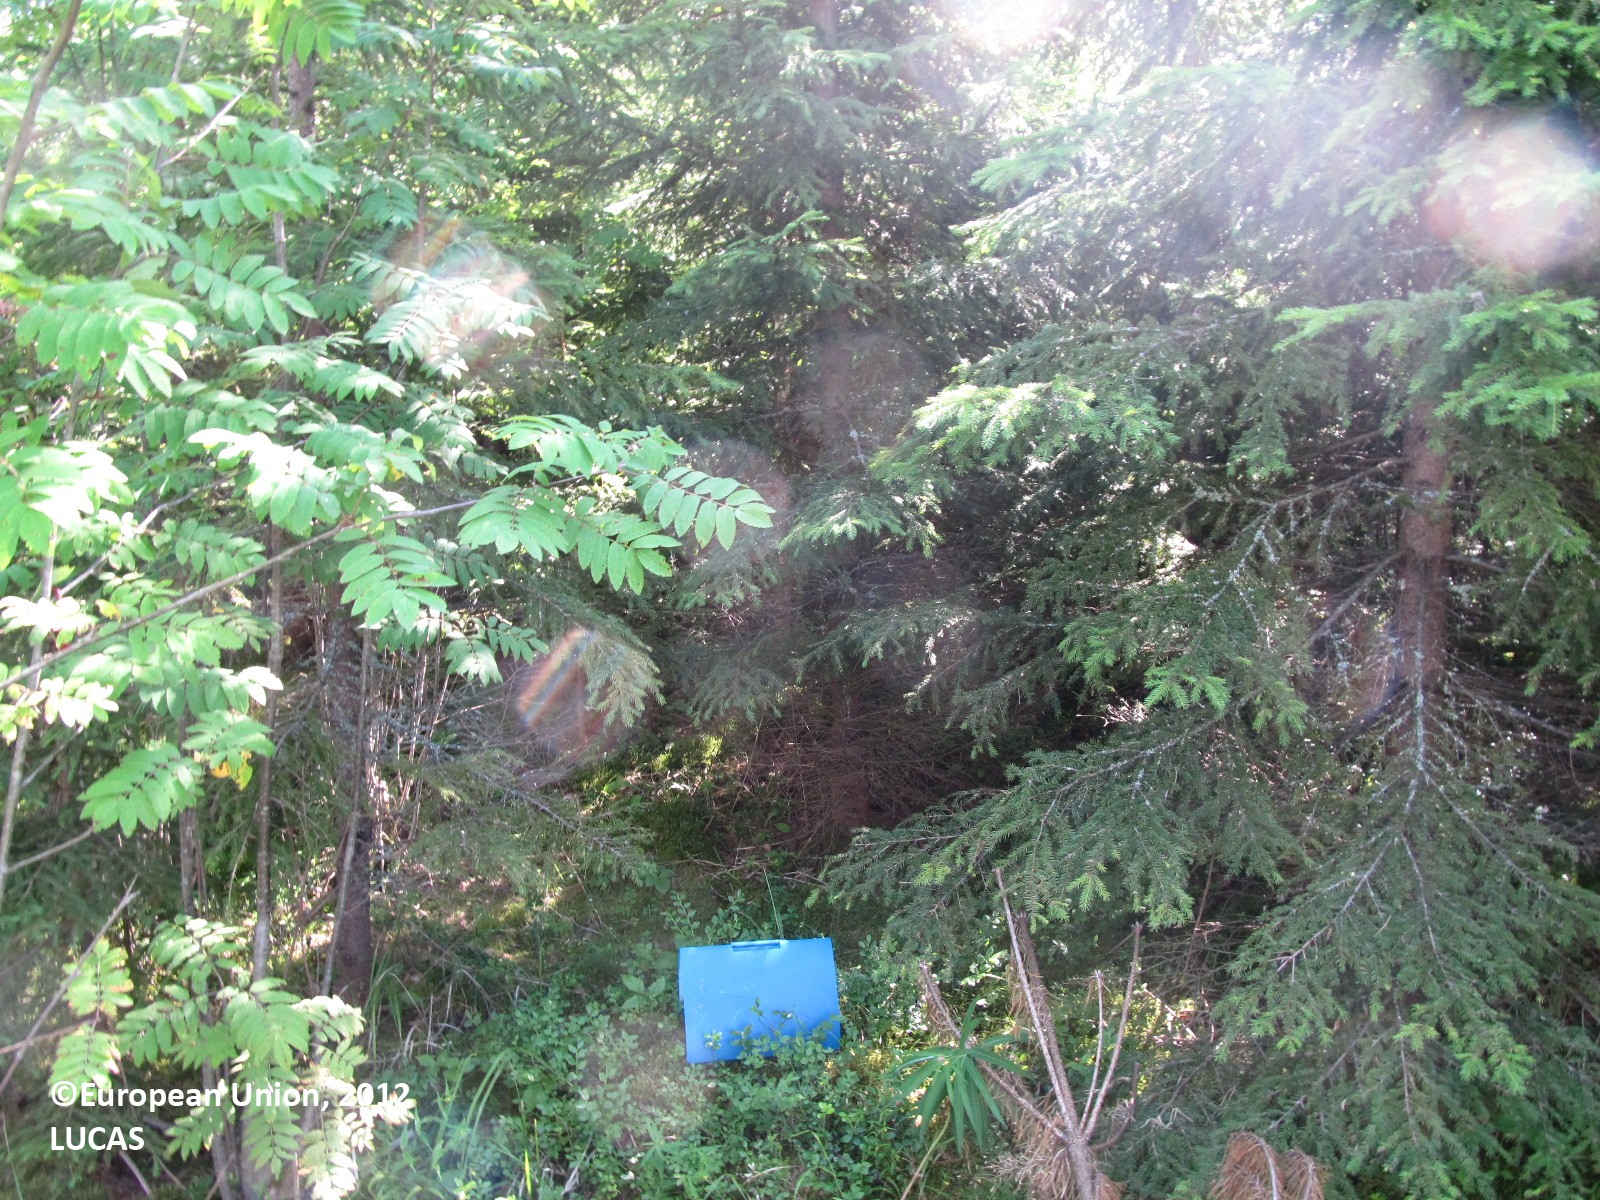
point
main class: Woodland
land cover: Spruce dominated mixed woodland
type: boreal forest
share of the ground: > 75 %
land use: Forestry
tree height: > 5 m
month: July
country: FI
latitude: 61.9427
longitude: 28.1277
